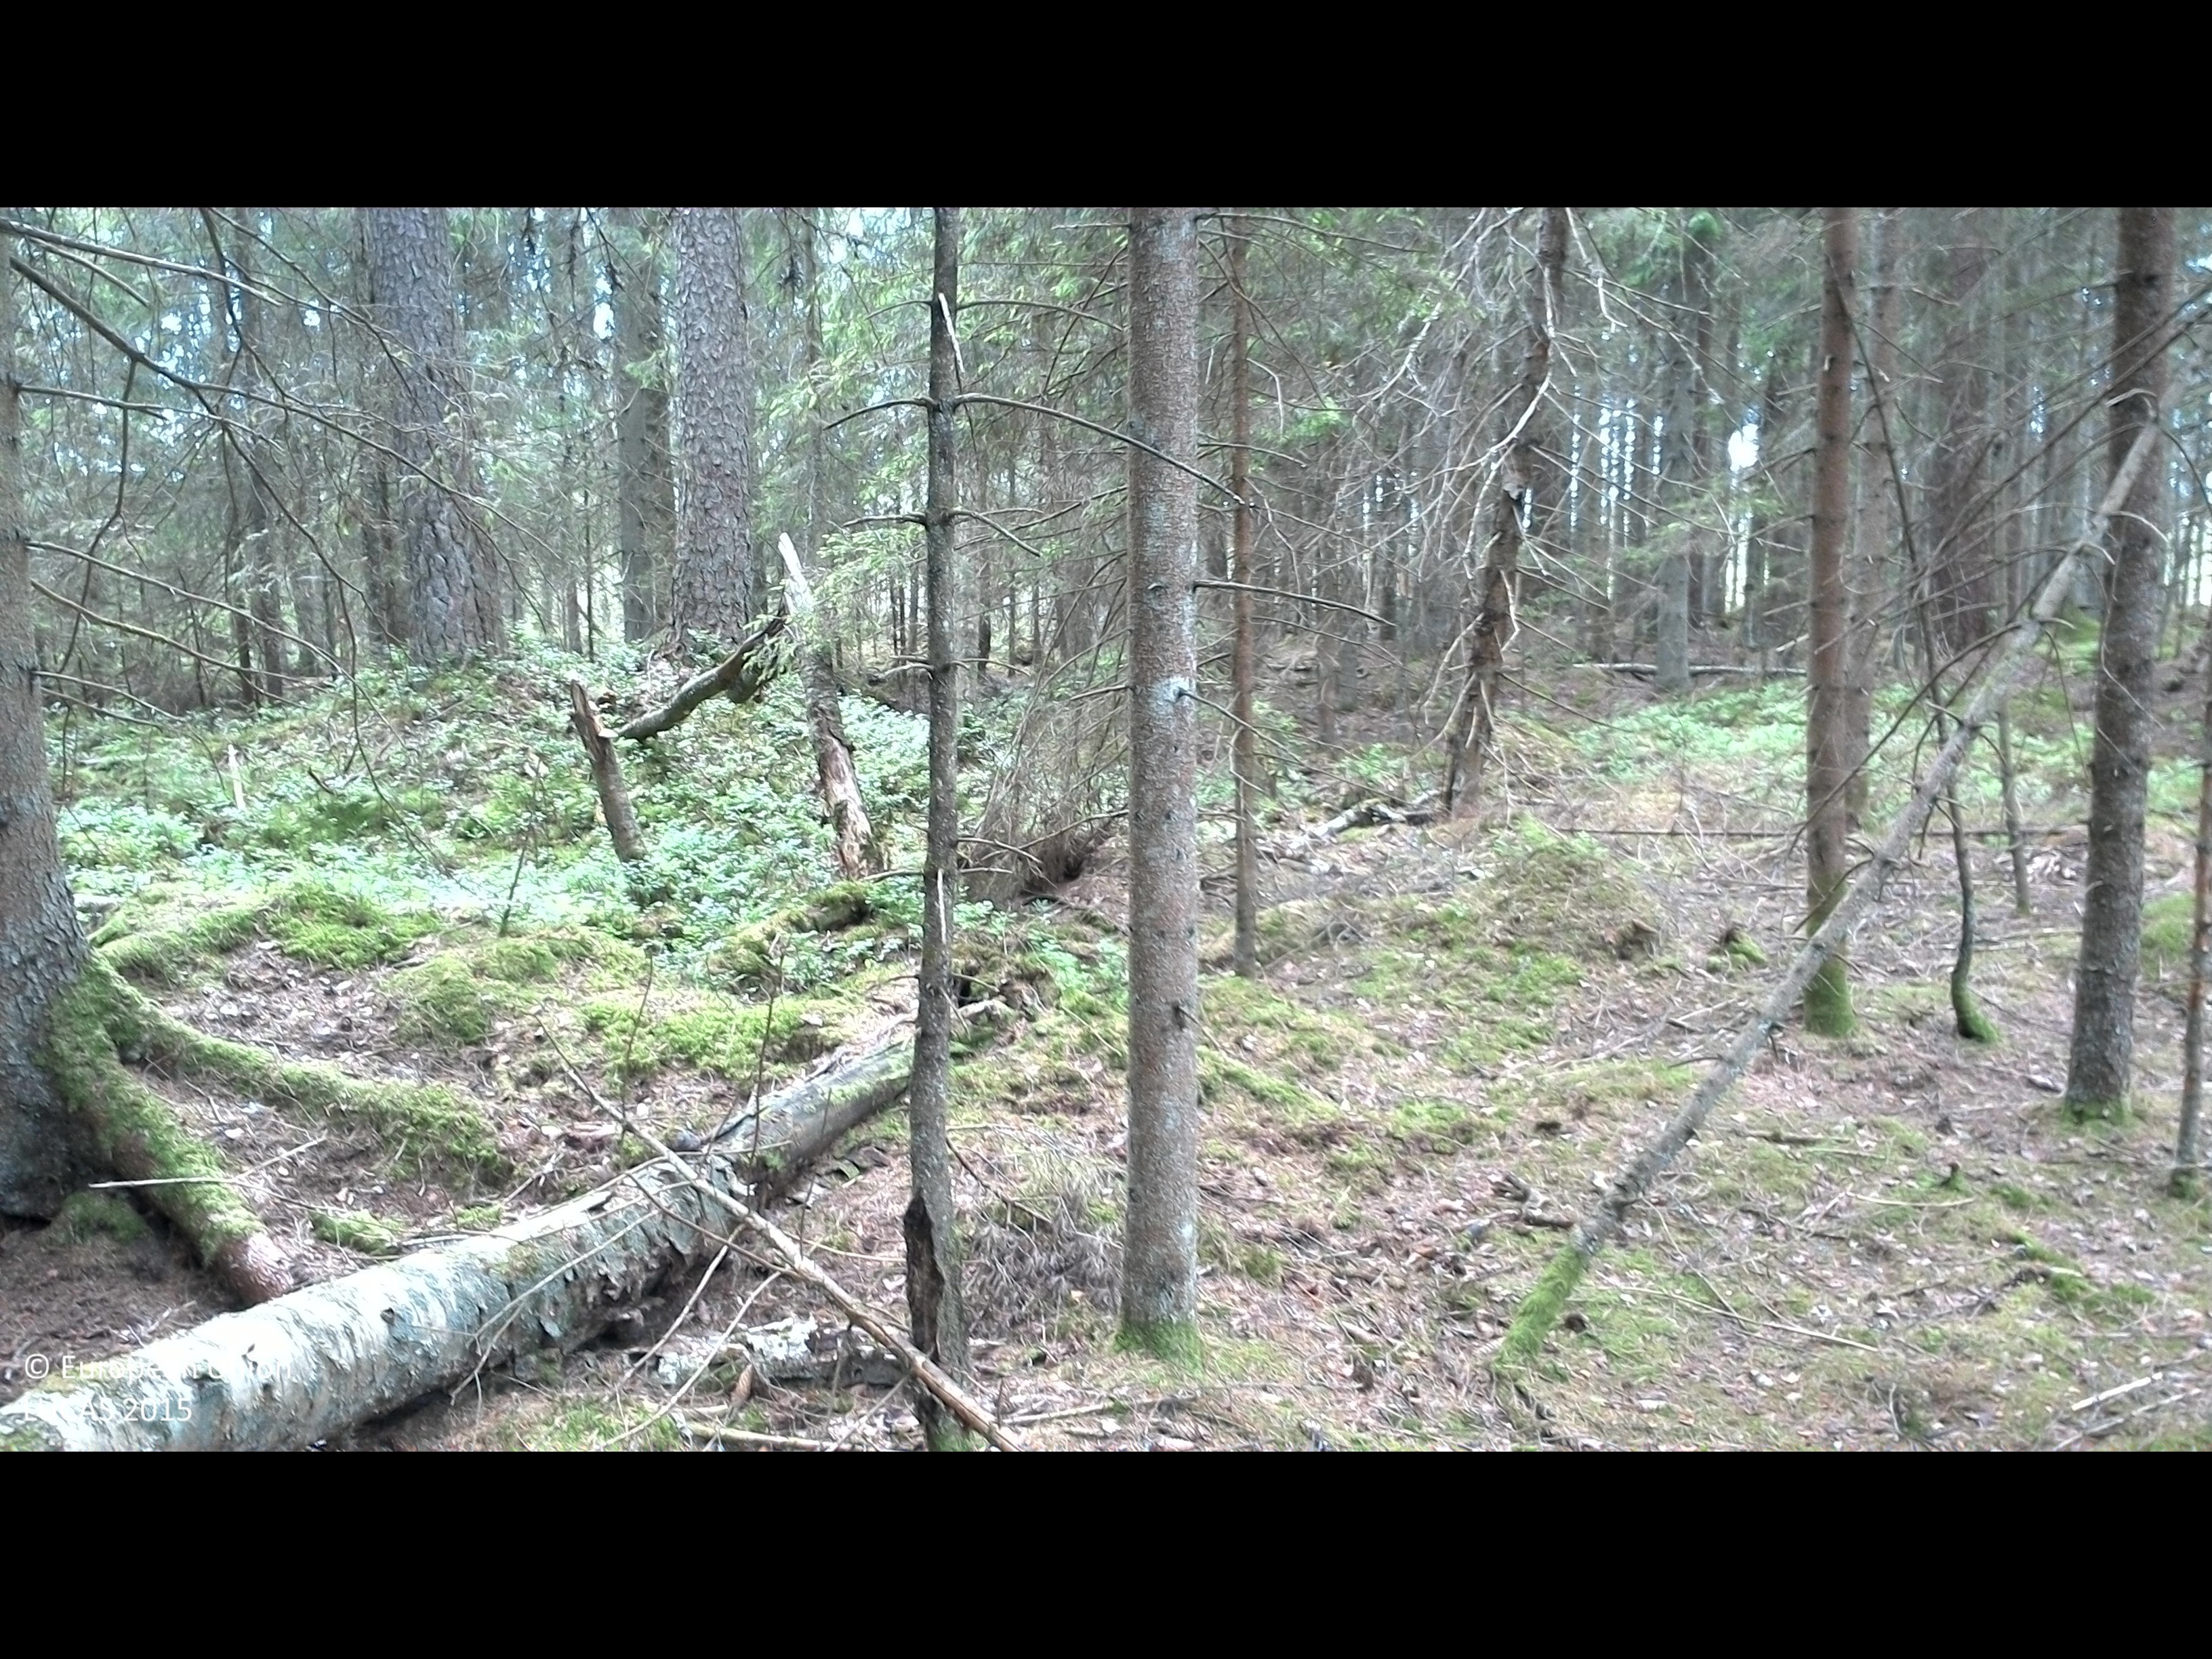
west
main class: Woodland
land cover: Spruce dominated coniferous woodland
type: boreal forest
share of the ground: 50 - 75 %
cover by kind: coniferous forest trees 75 %, lichens and mosses 15 %, shrubs 10 %
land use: Forestry
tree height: > 5 m
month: July
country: SE
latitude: 56.4093
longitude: 15.1360
